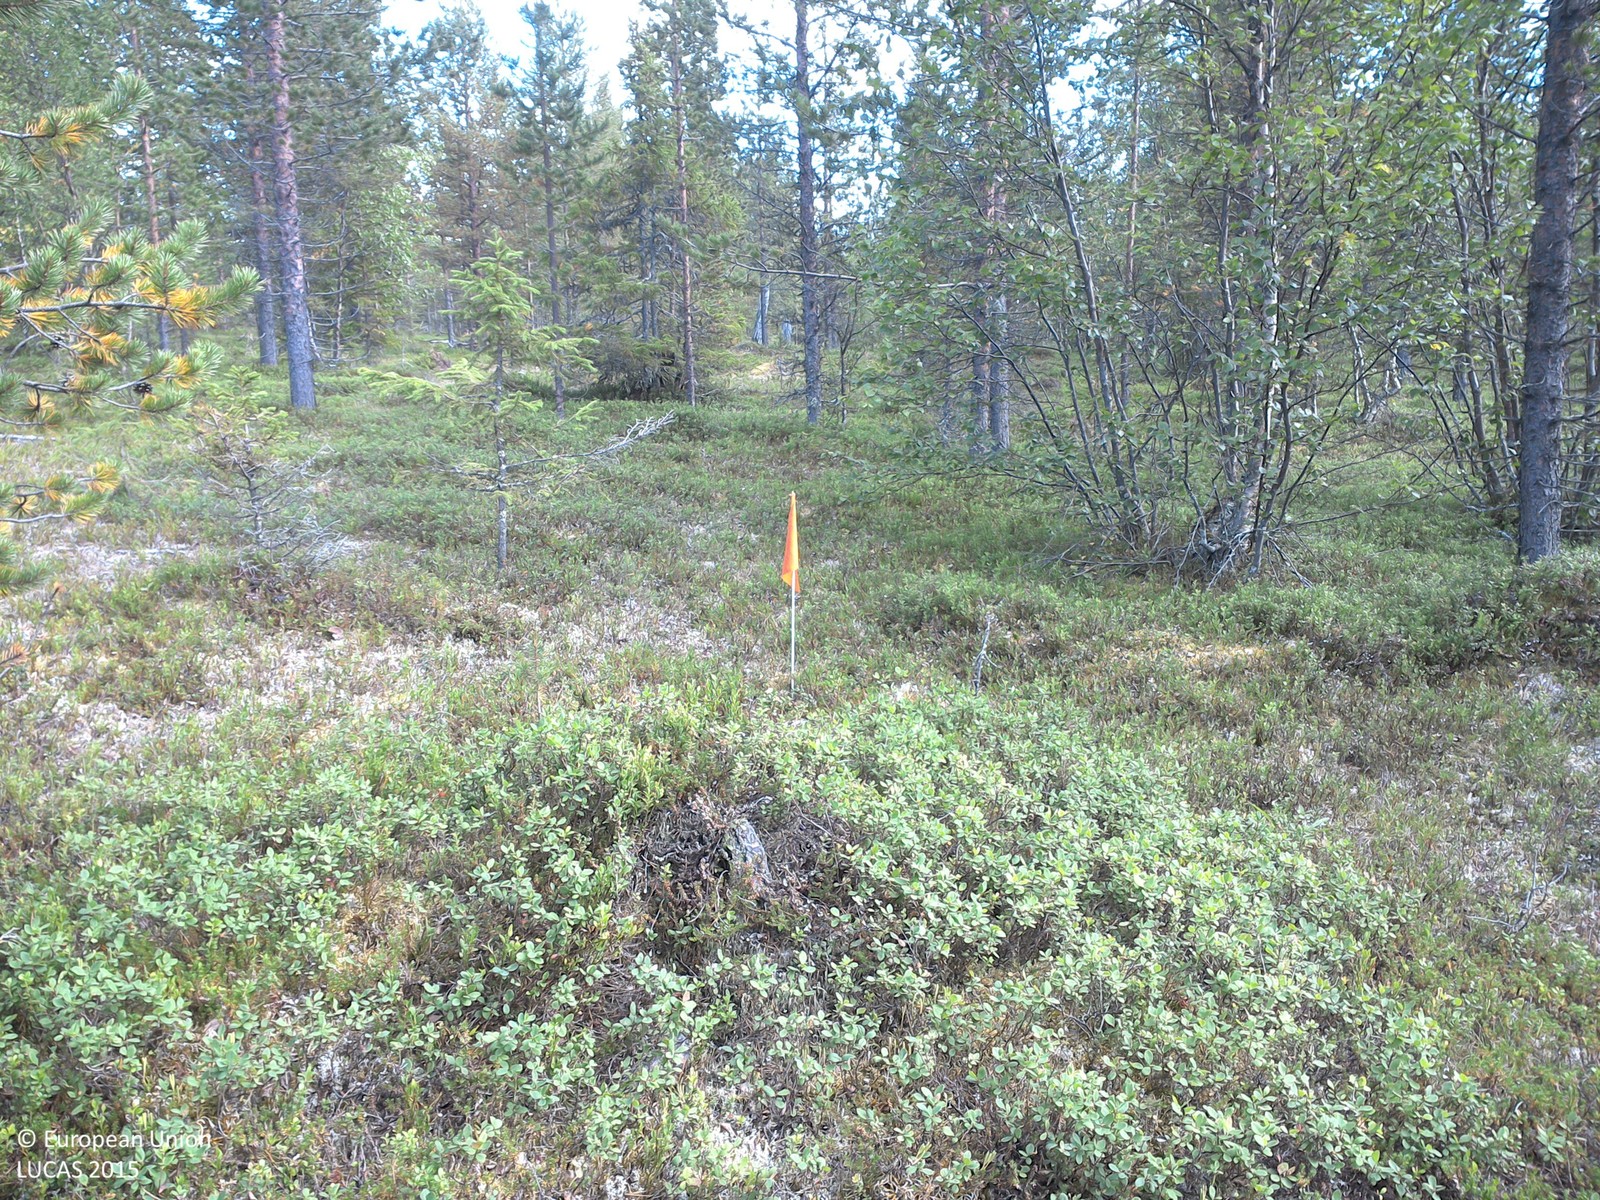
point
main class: Woodland
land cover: Pine dominated mixed woodland
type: boreal forest
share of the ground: 25 - 50 %
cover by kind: shrubs 50 %, coniferous forest trees 20 %, broadleaved forest trees 15 %, lichens and mosses 15 %
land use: Forestry
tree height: < 5 m
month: August
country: SE
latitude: 67.9048
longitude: 20.5406
